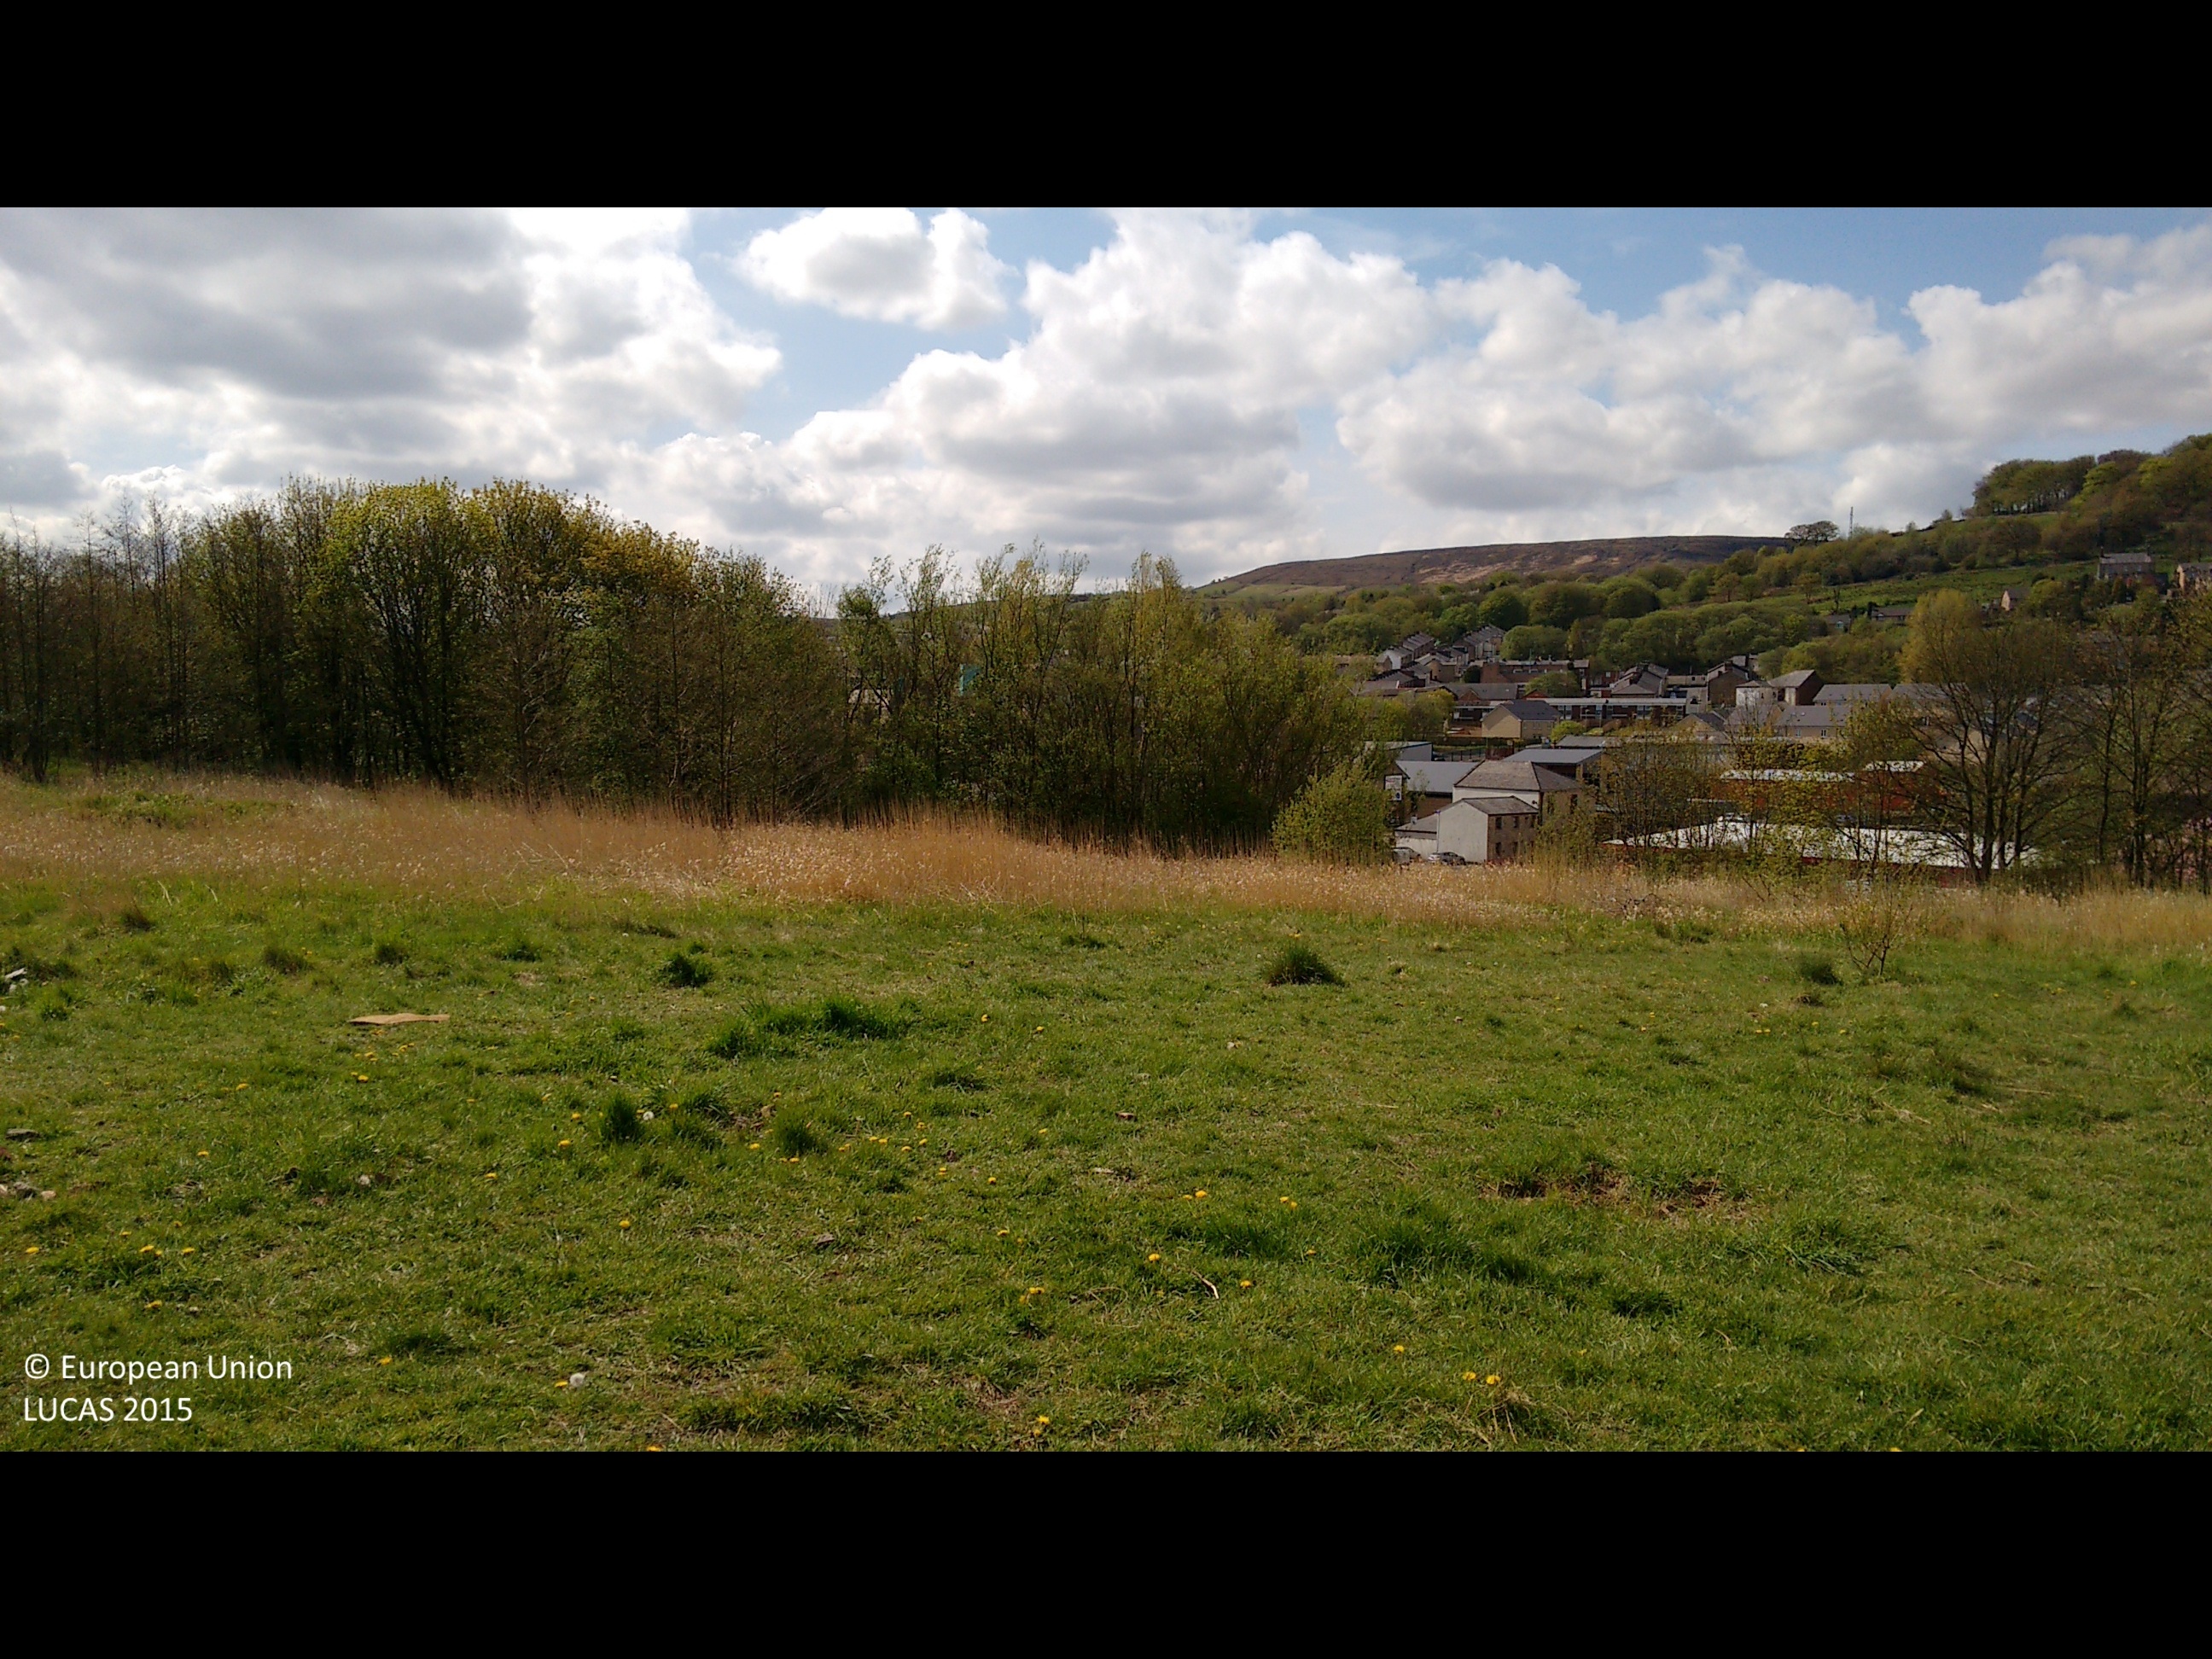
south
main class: Grassland
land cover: Grassland without tree/shrub cover
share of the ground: > 75 %
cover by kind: herbaceous plants 100 %
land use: Semi-natural and natural areas not in use
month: May
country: GB
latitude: 53.7008
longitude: -2.4702
